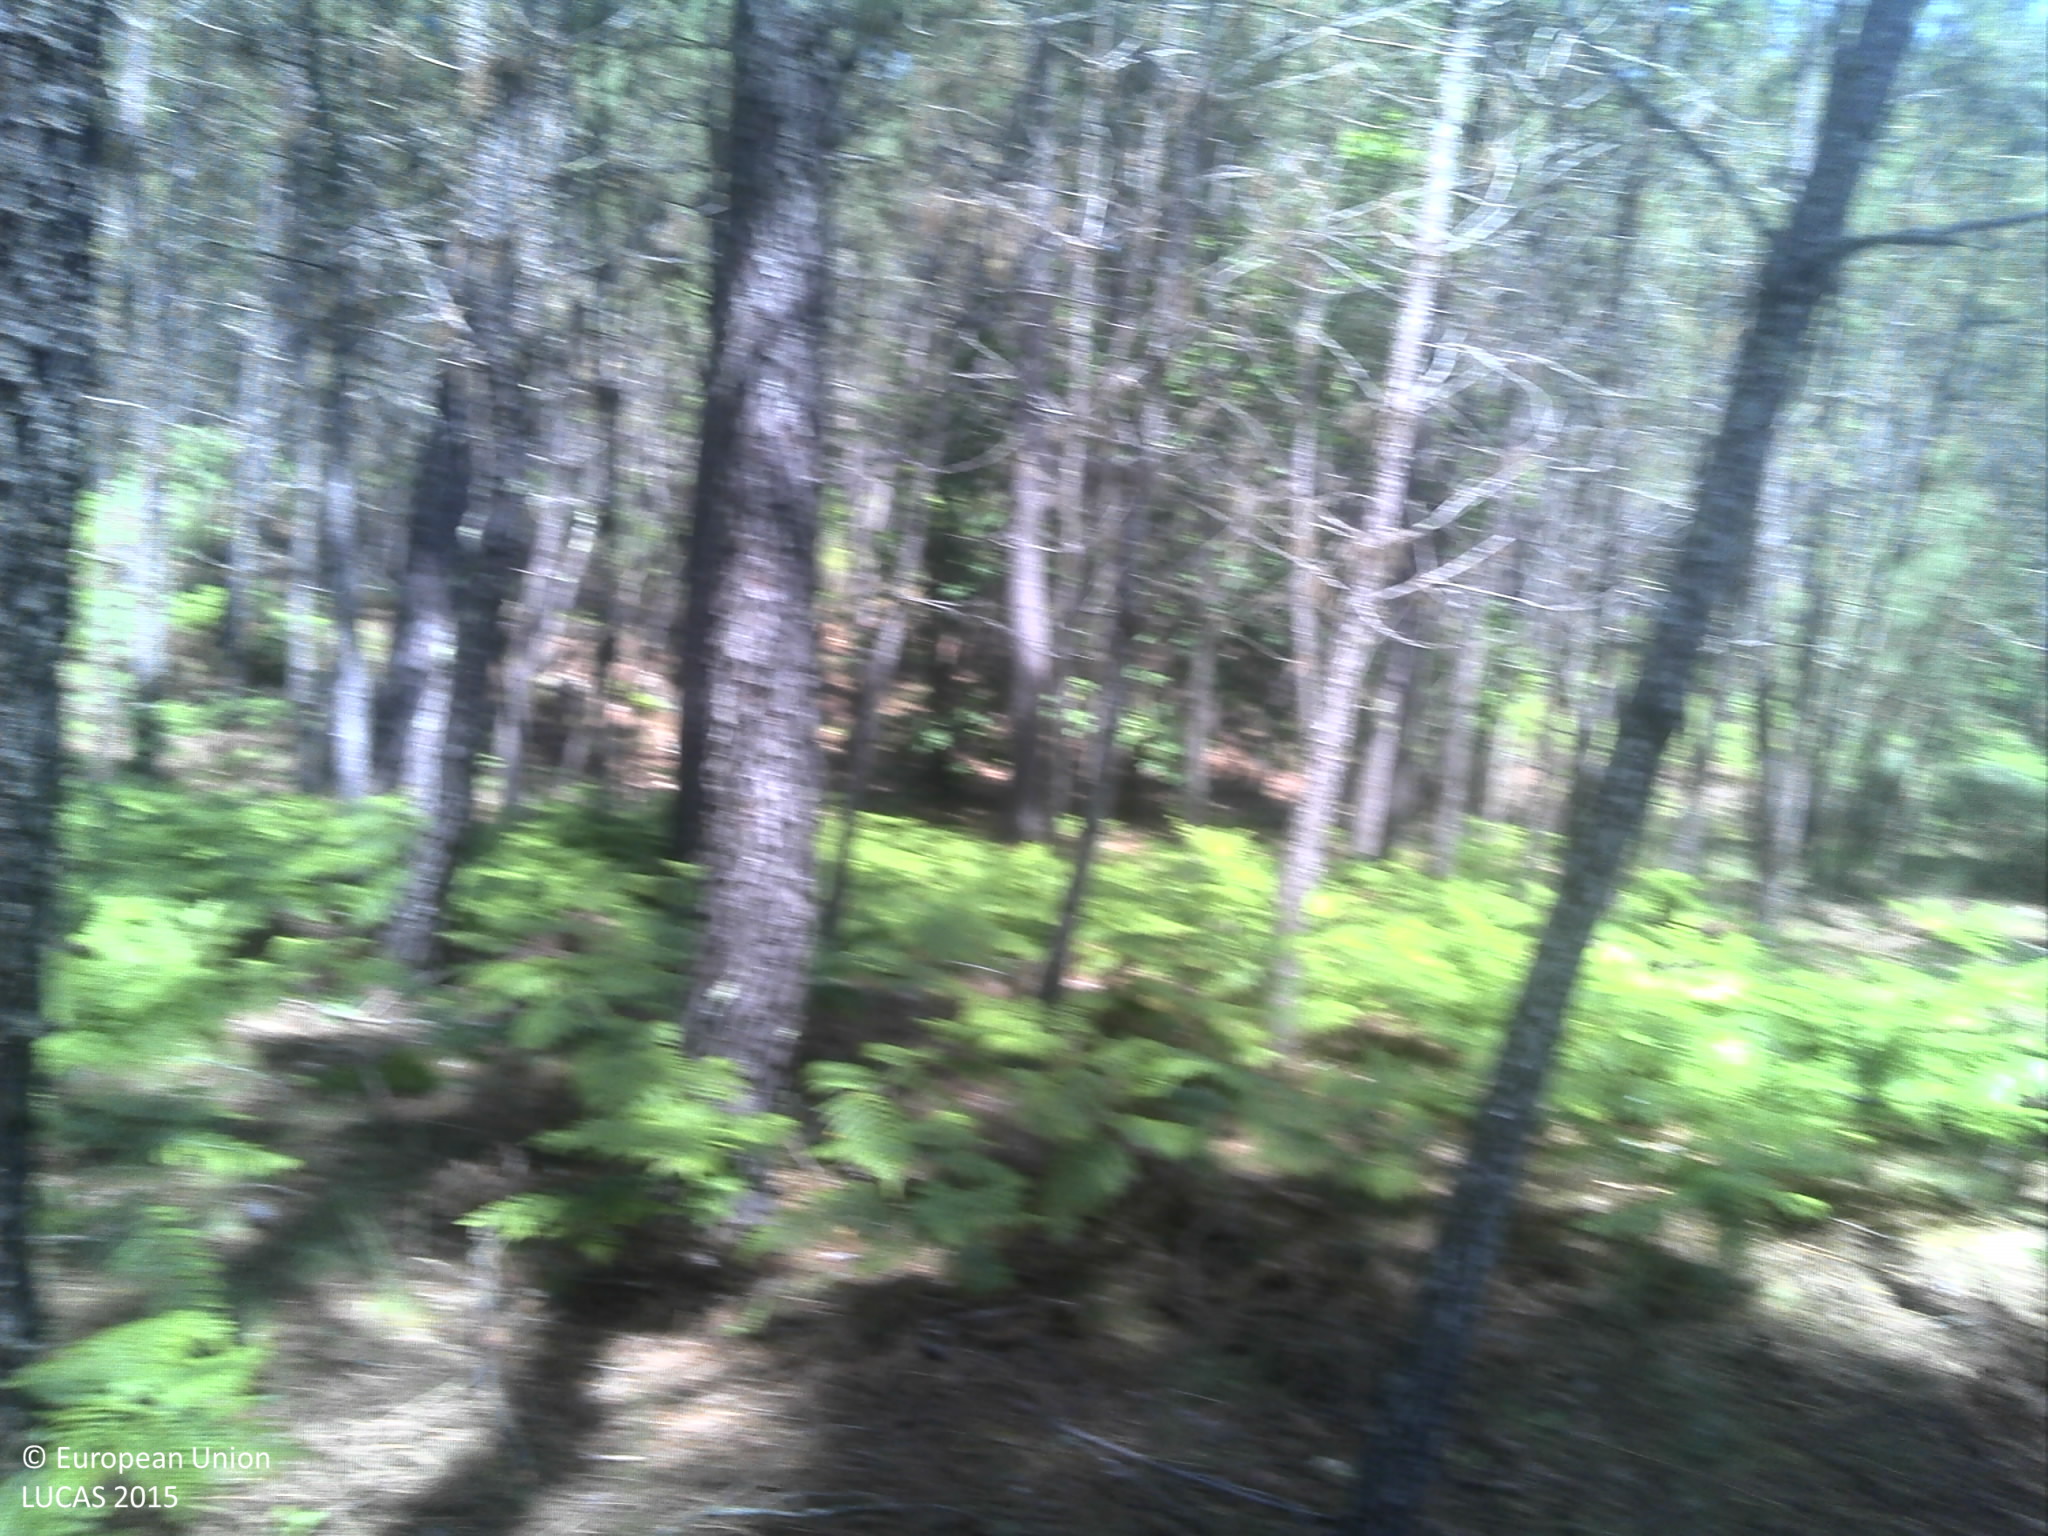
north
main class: Woodland
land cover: Pine dominated coniferous woodland
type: coniferous forest of the mediterranean region
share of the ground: > 75 %
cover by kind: coniferous forest trees 90 %, shrubs 10 %
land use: Forestry
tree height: > 5 m
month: May
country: PT
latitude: 40.6907
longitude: -7.8132
